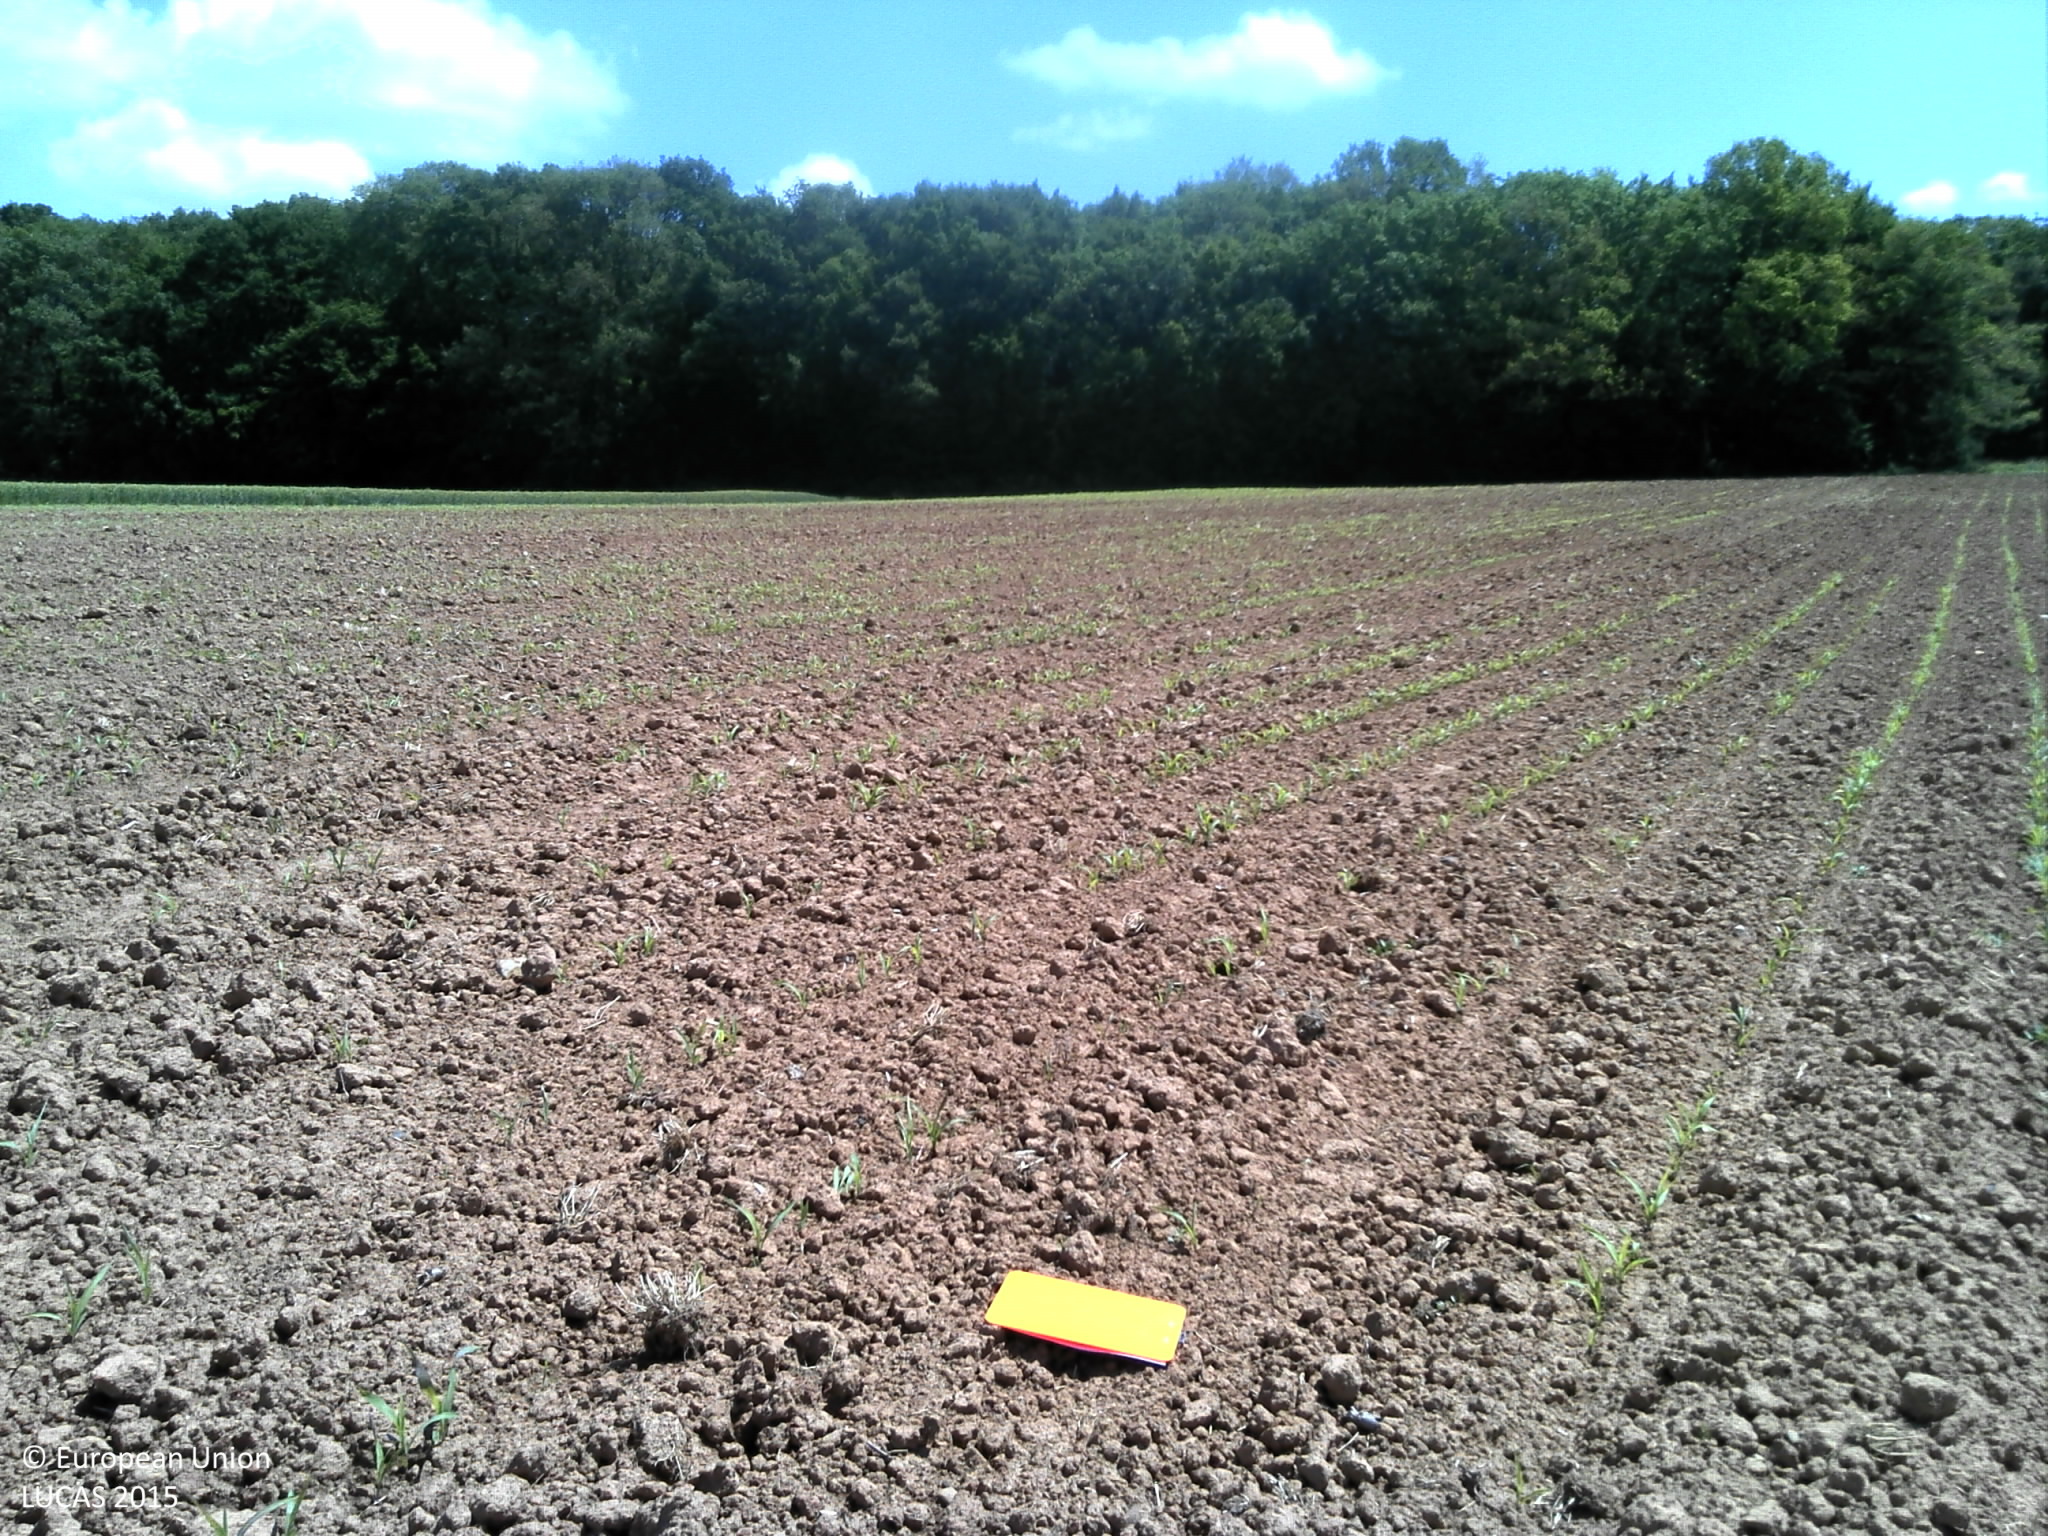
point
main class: Cropland
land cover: Maize
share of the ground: < 10 %
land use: Agriculture (excluding fallow land and kitchen gardens)
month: June
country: FR
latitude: 48.9863
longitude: 6.7617
